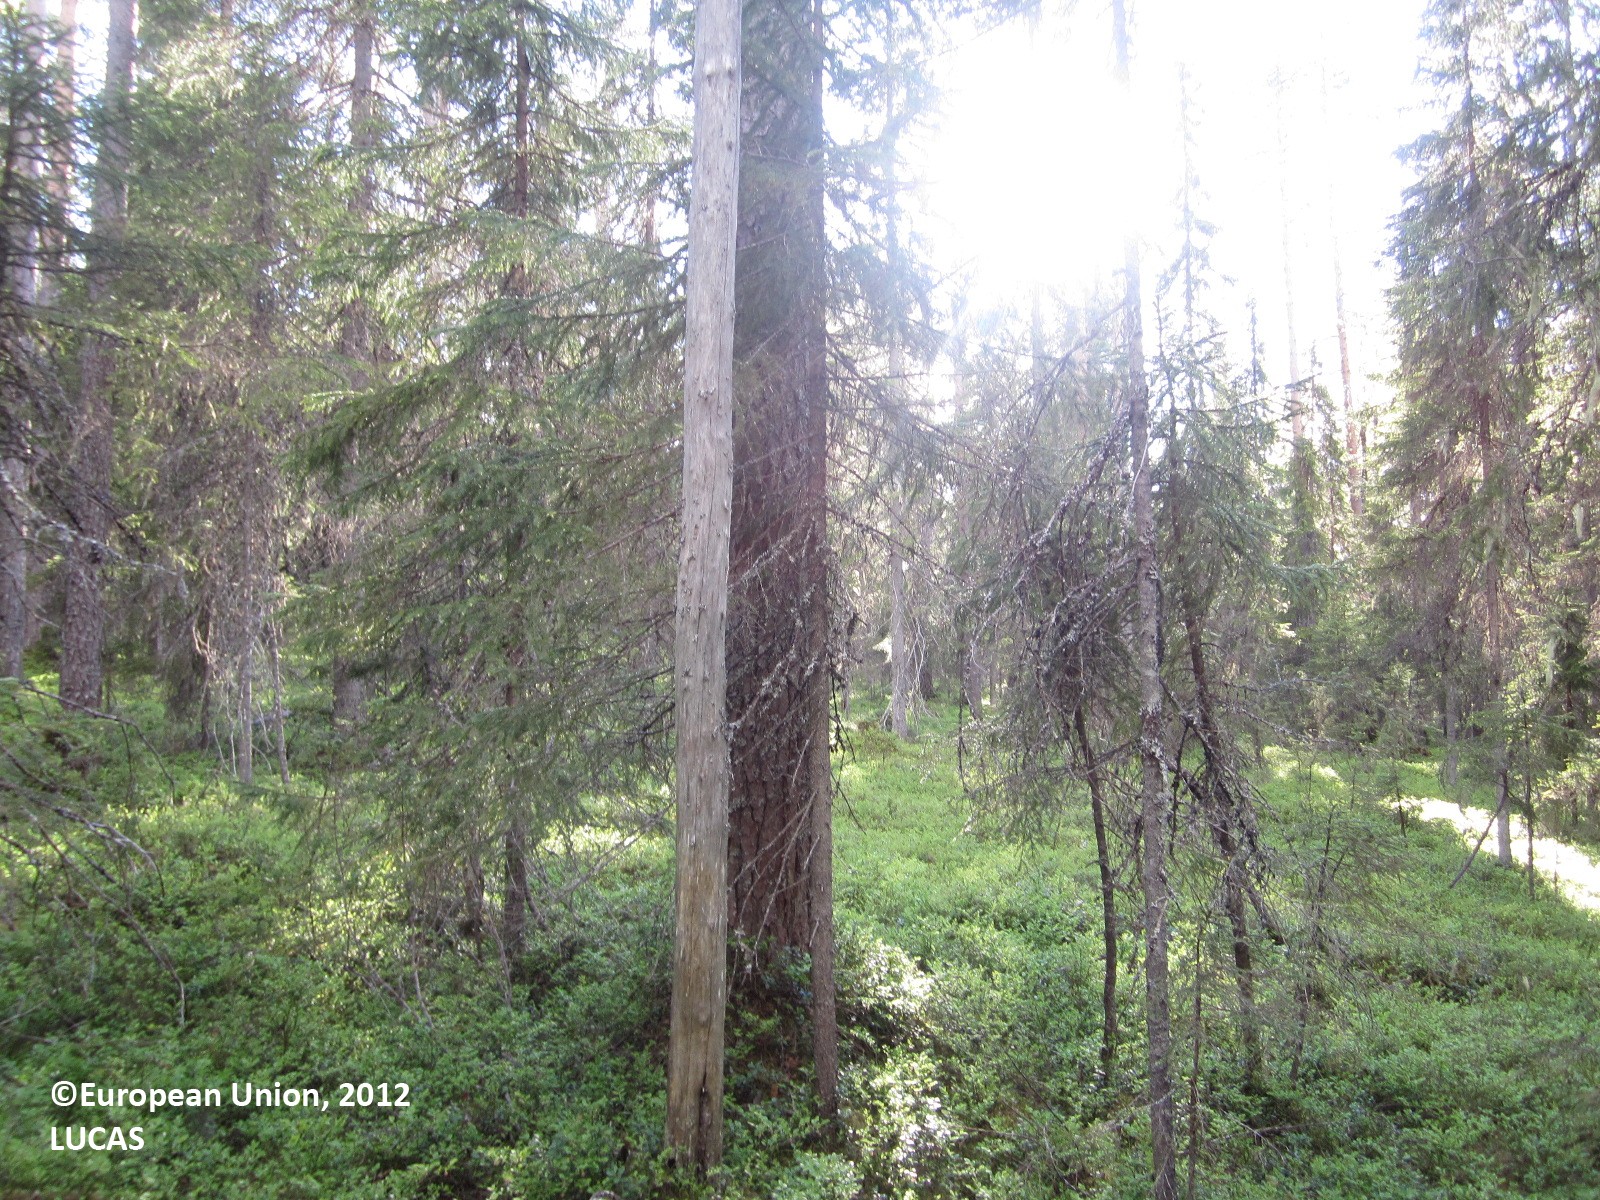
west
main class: Woodland
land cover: Spruce dominated coniferous woodland
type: boreal forest
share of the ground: > 75 %
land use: Forestry
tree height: > 5 m
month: June
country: FI
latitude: 64.7036
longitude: 28.7444
